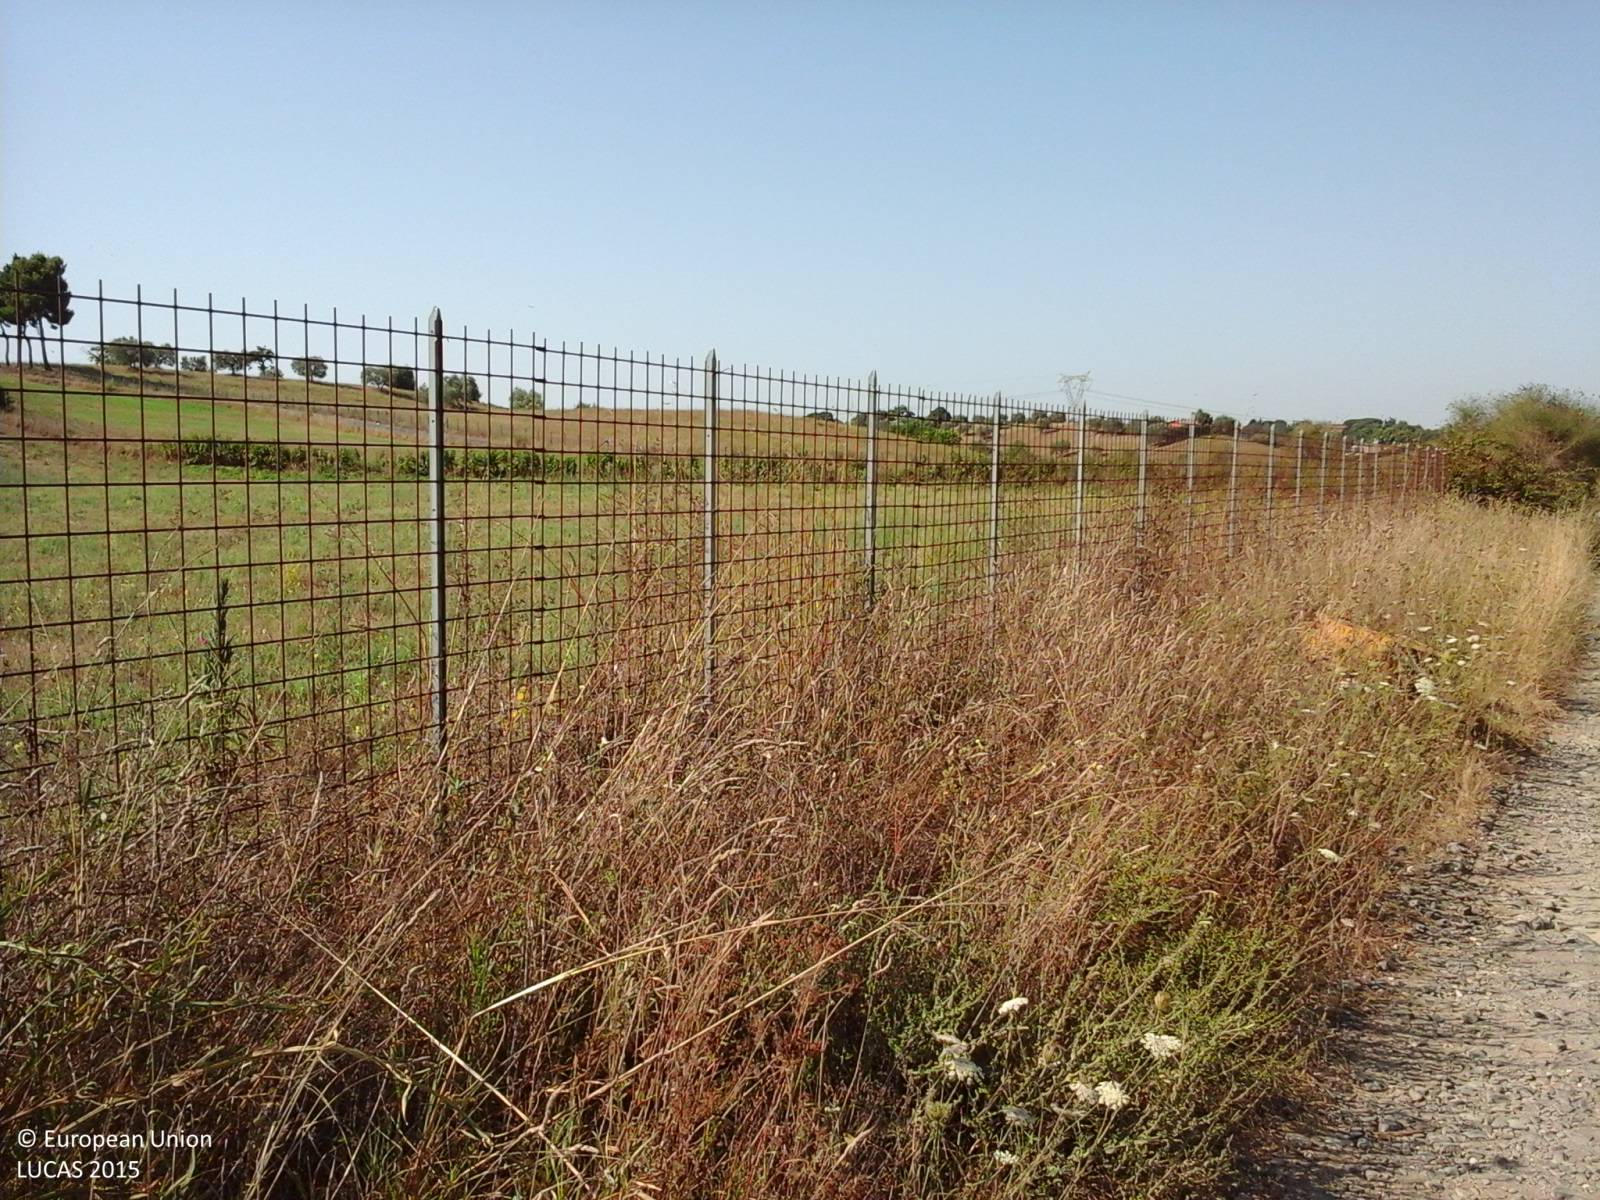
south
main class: Cropland
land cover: Mixed cereals for fodder
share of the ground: > 75 %
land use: Agriculture (excluding fallow land and kitchen gardens)
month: August
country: IT
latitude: 42.0852
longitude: 12.3247
